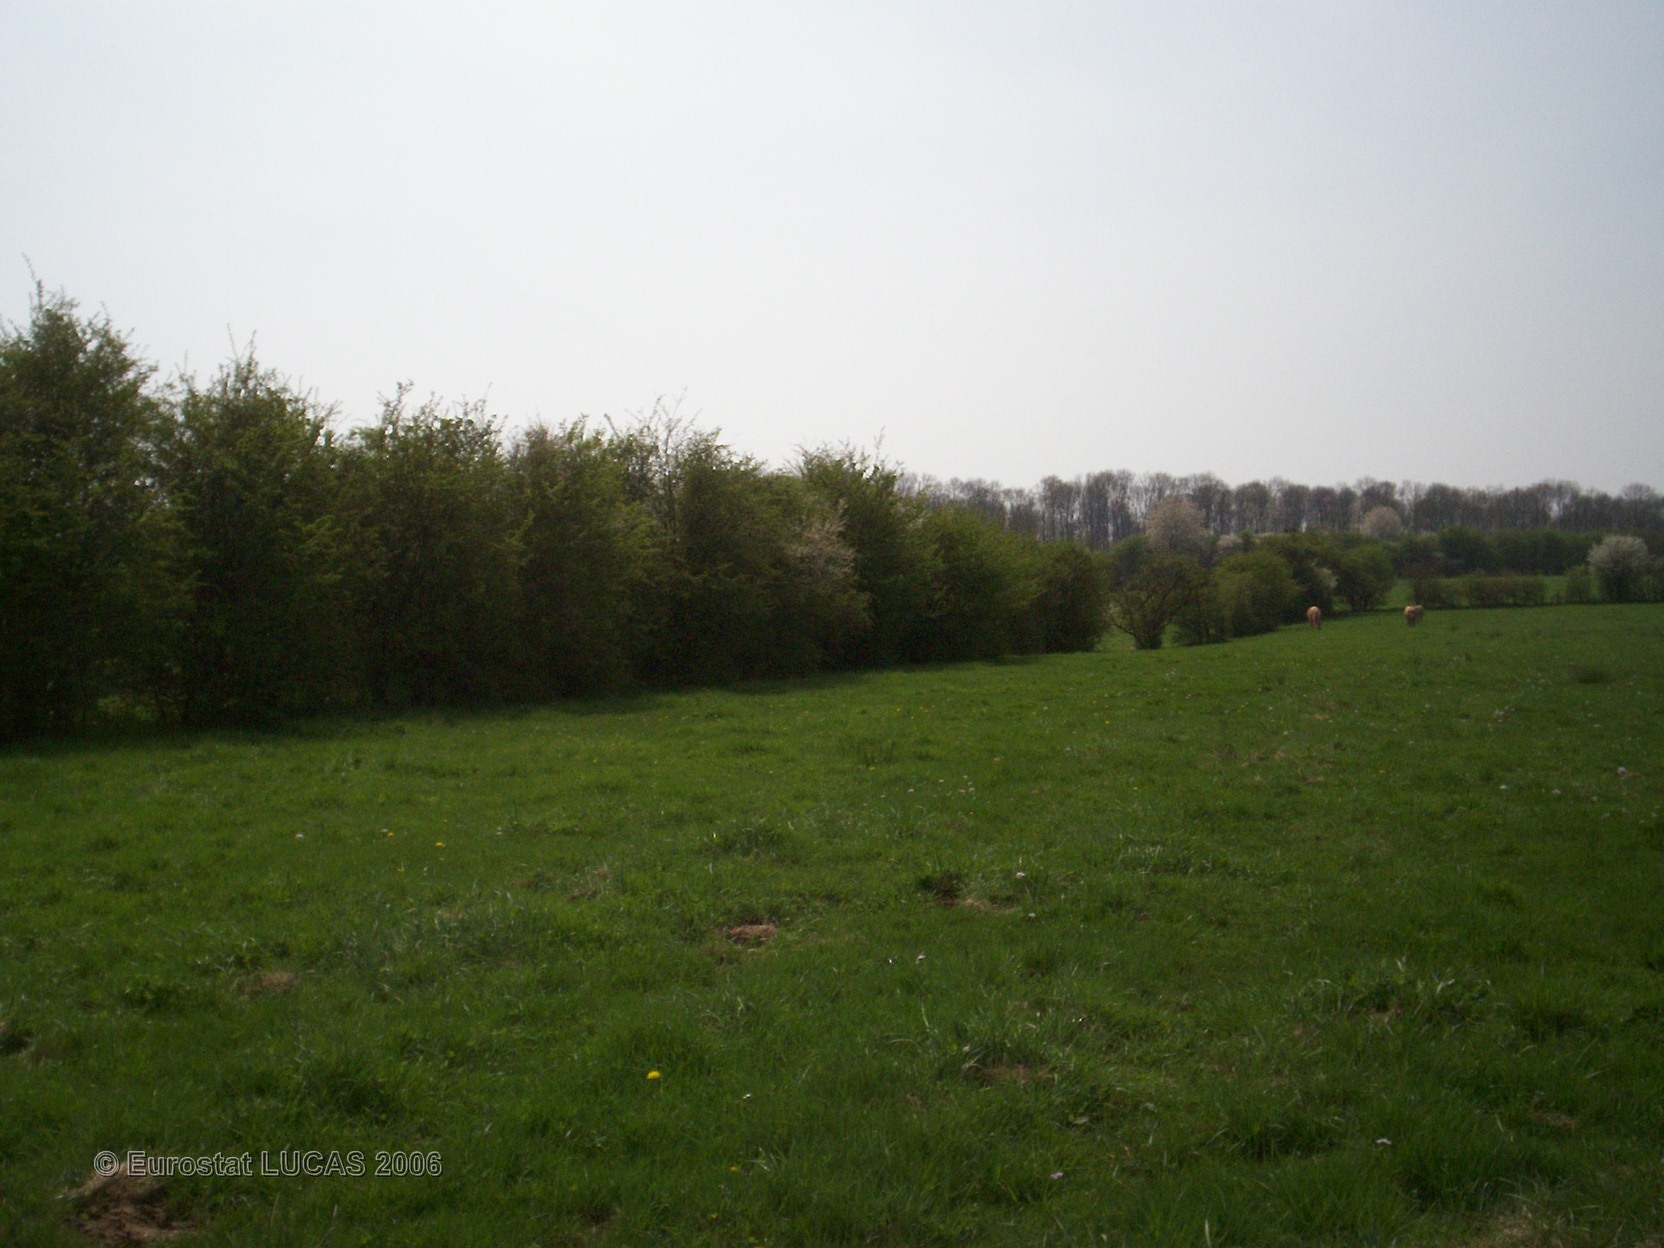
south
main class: Grassland
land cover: Grassland without tree/shrub cover
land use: Agriculture (excluding fallow land and kitchen gardens)
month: May
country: FR
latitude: 49.8796
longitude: 4.3037
